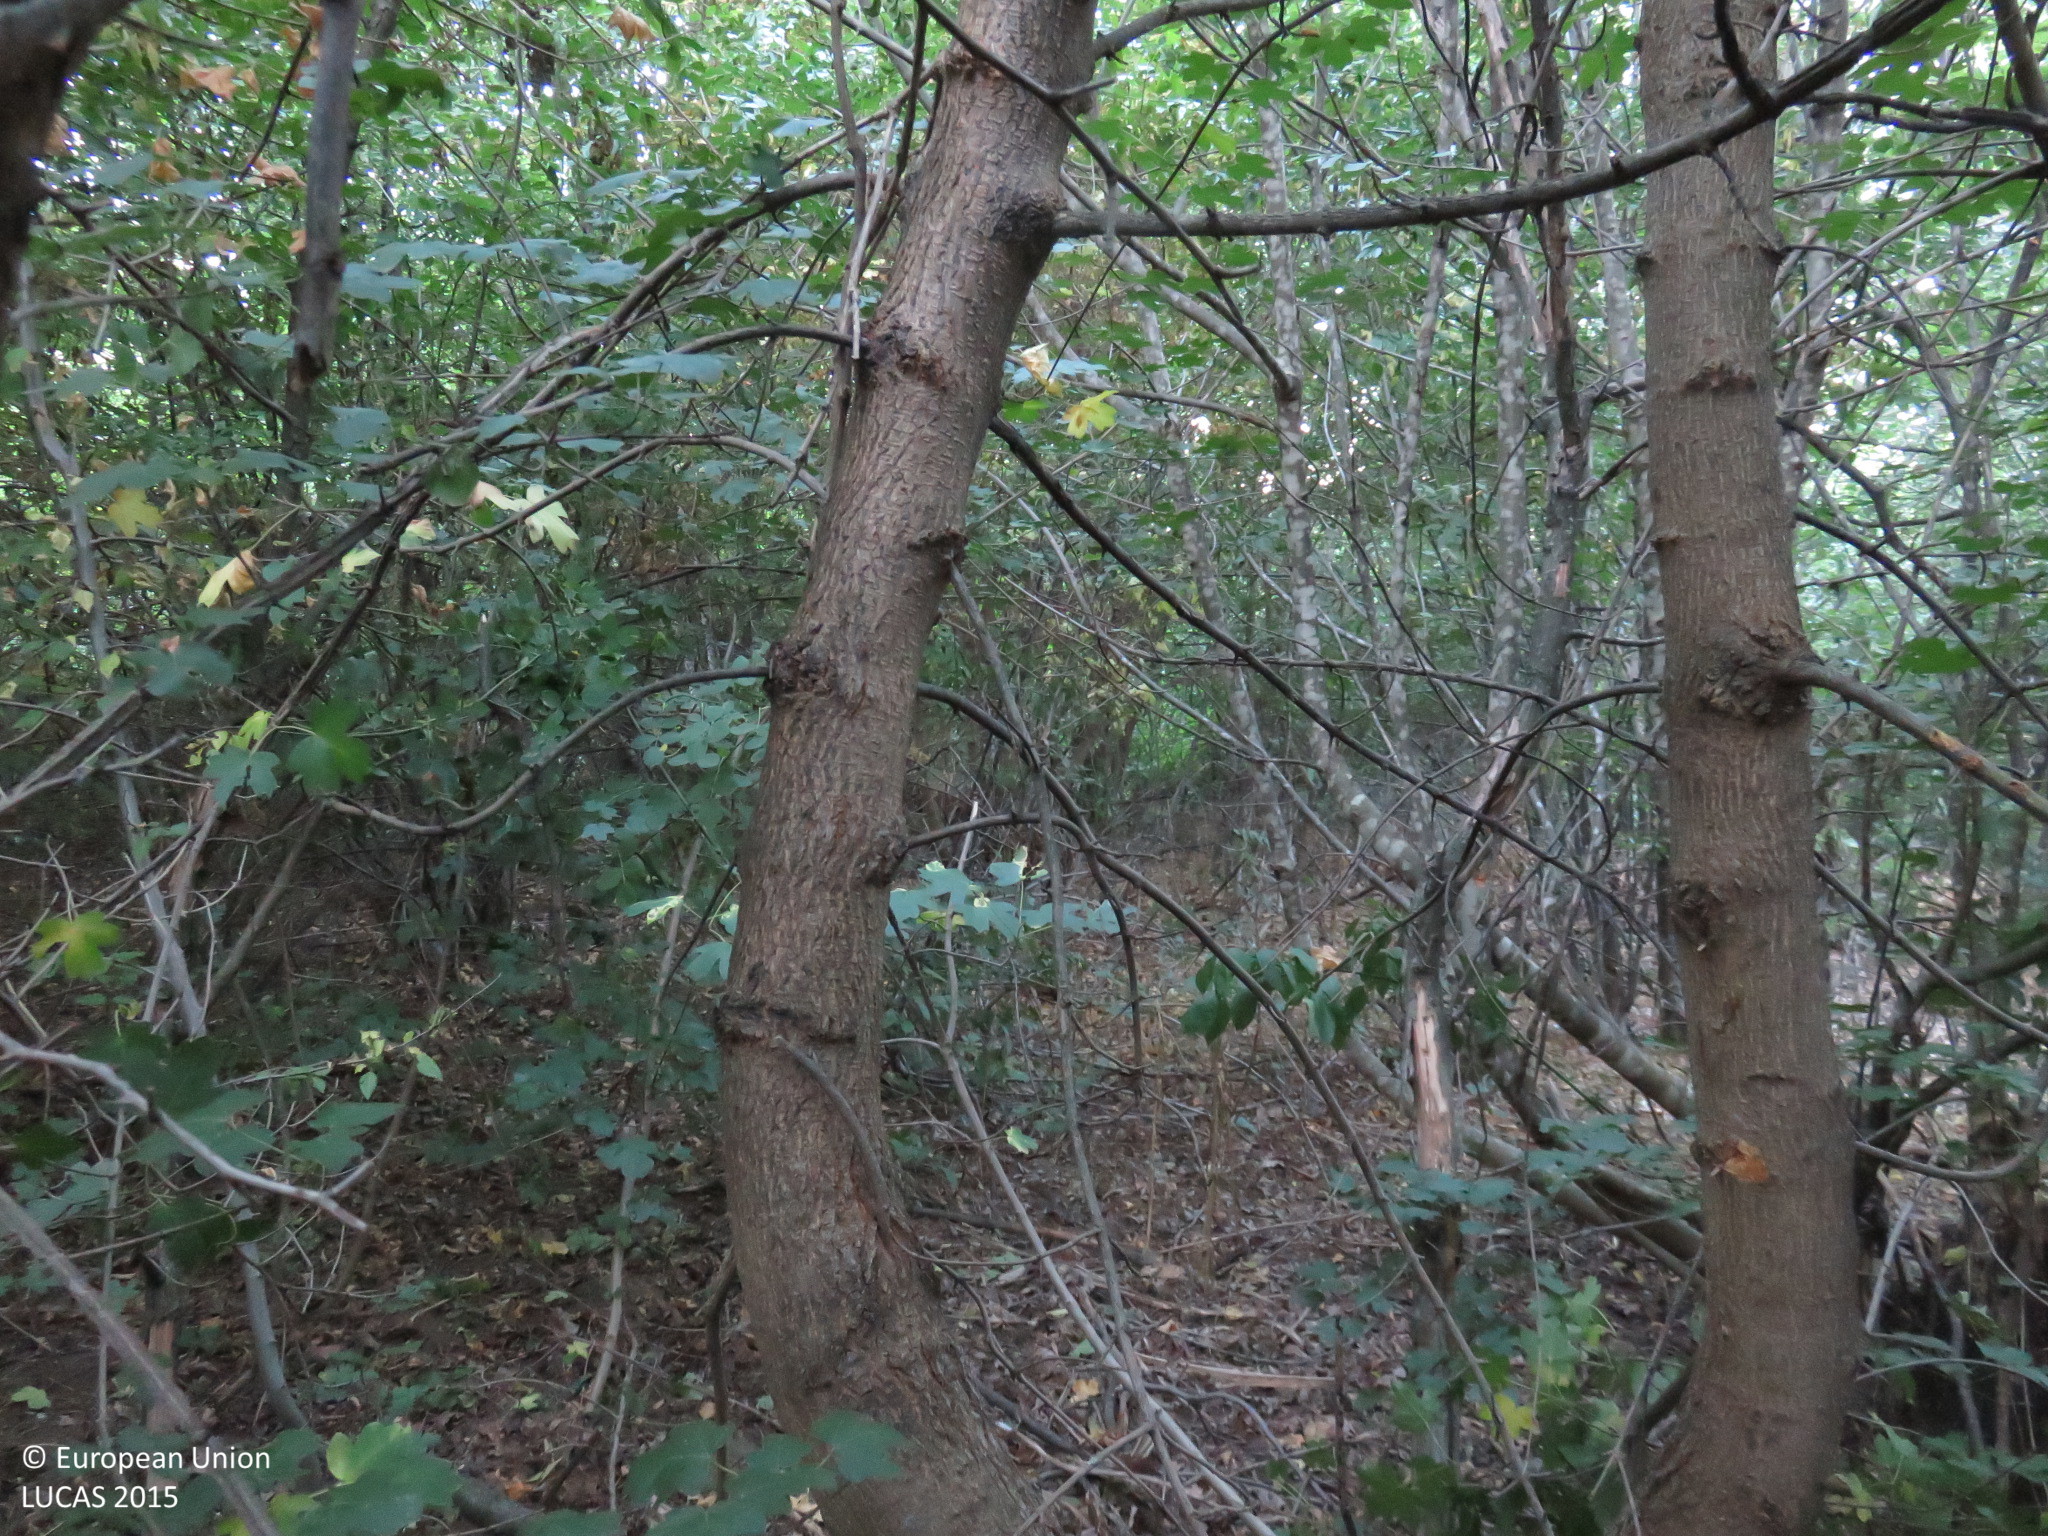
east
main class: Woodland
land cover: Broadleaved woodland
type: mesophytic deciduous forest
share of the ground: > 75 %
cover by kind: broadleaved forest trees 75 %, shrubs 25 %
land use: Forestry
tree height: < 5 m
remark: Clear cut
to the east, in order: Broadleaved woodland; Grass margins; Common wheat
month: July
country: BG
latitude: 43.2438
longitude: 25.1833
